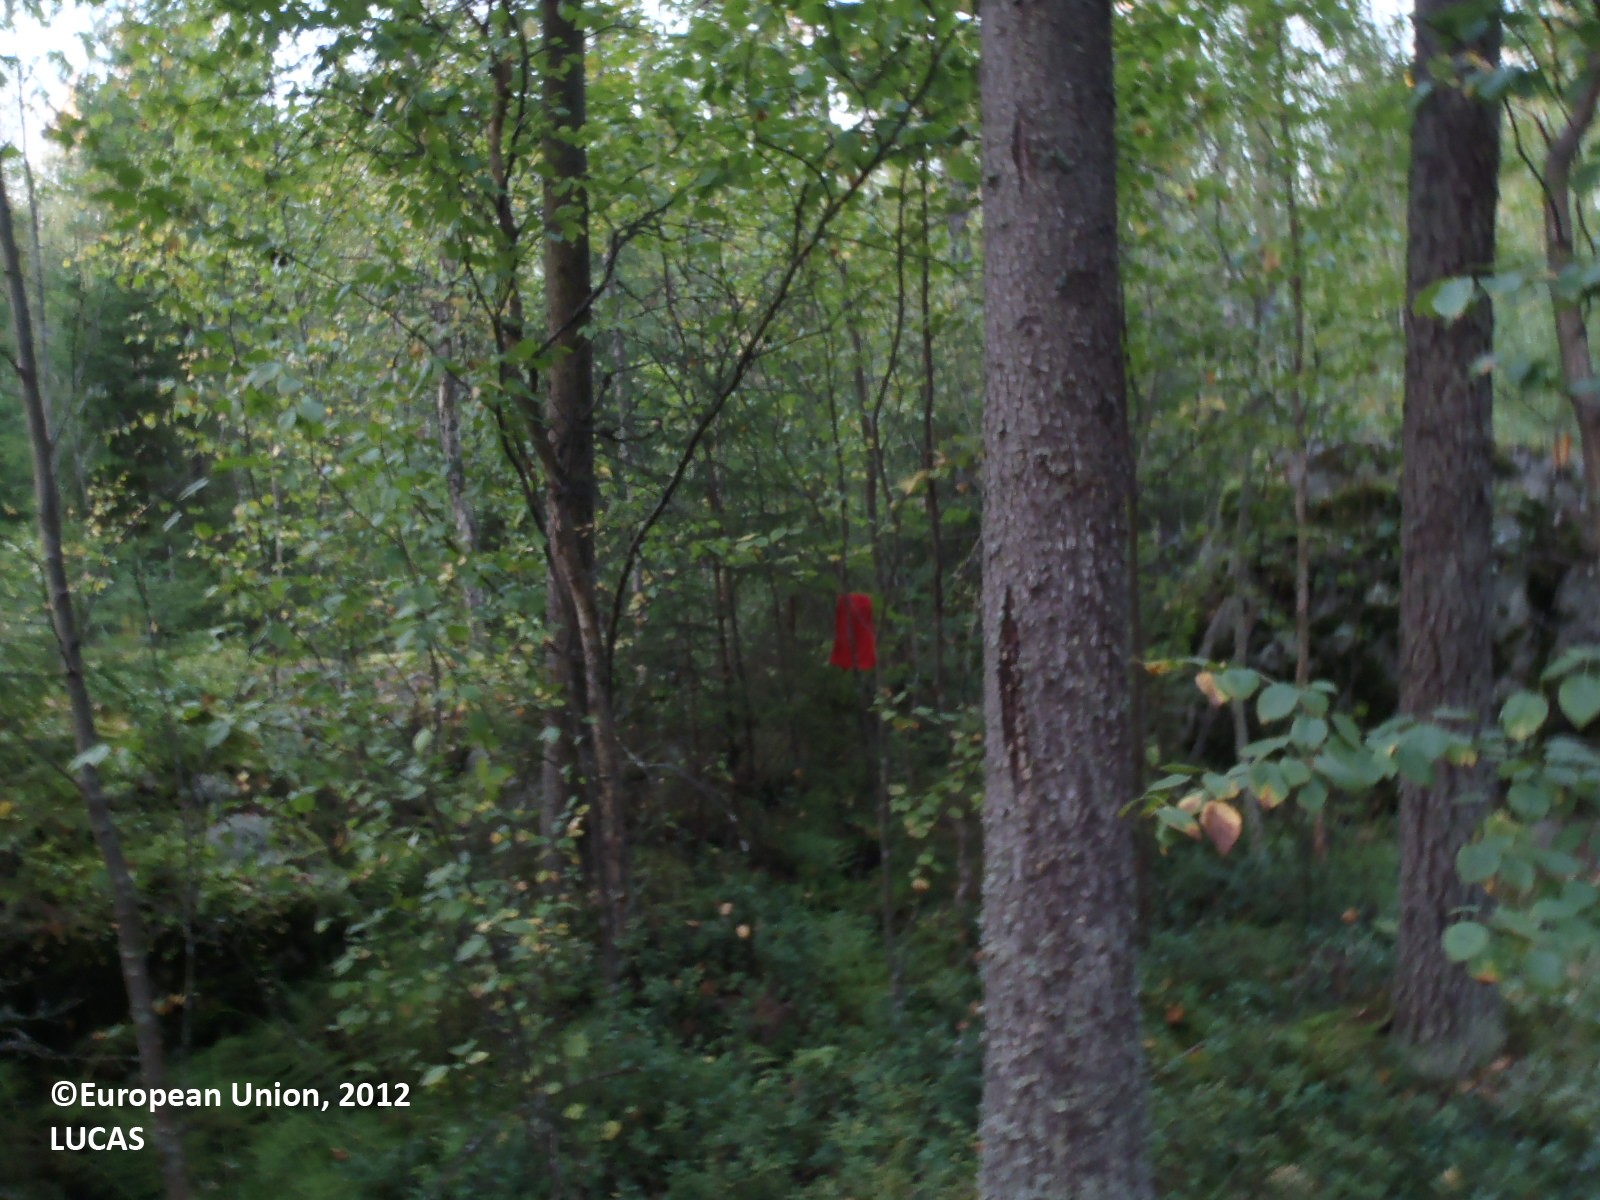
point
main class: Woodland
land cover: Pine dominated mixed woodland
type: boreal forest
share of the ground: > 75 %
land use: Forestry
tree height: > 5 m
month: September
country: FI
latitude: 61.3270
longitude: 22.6405
